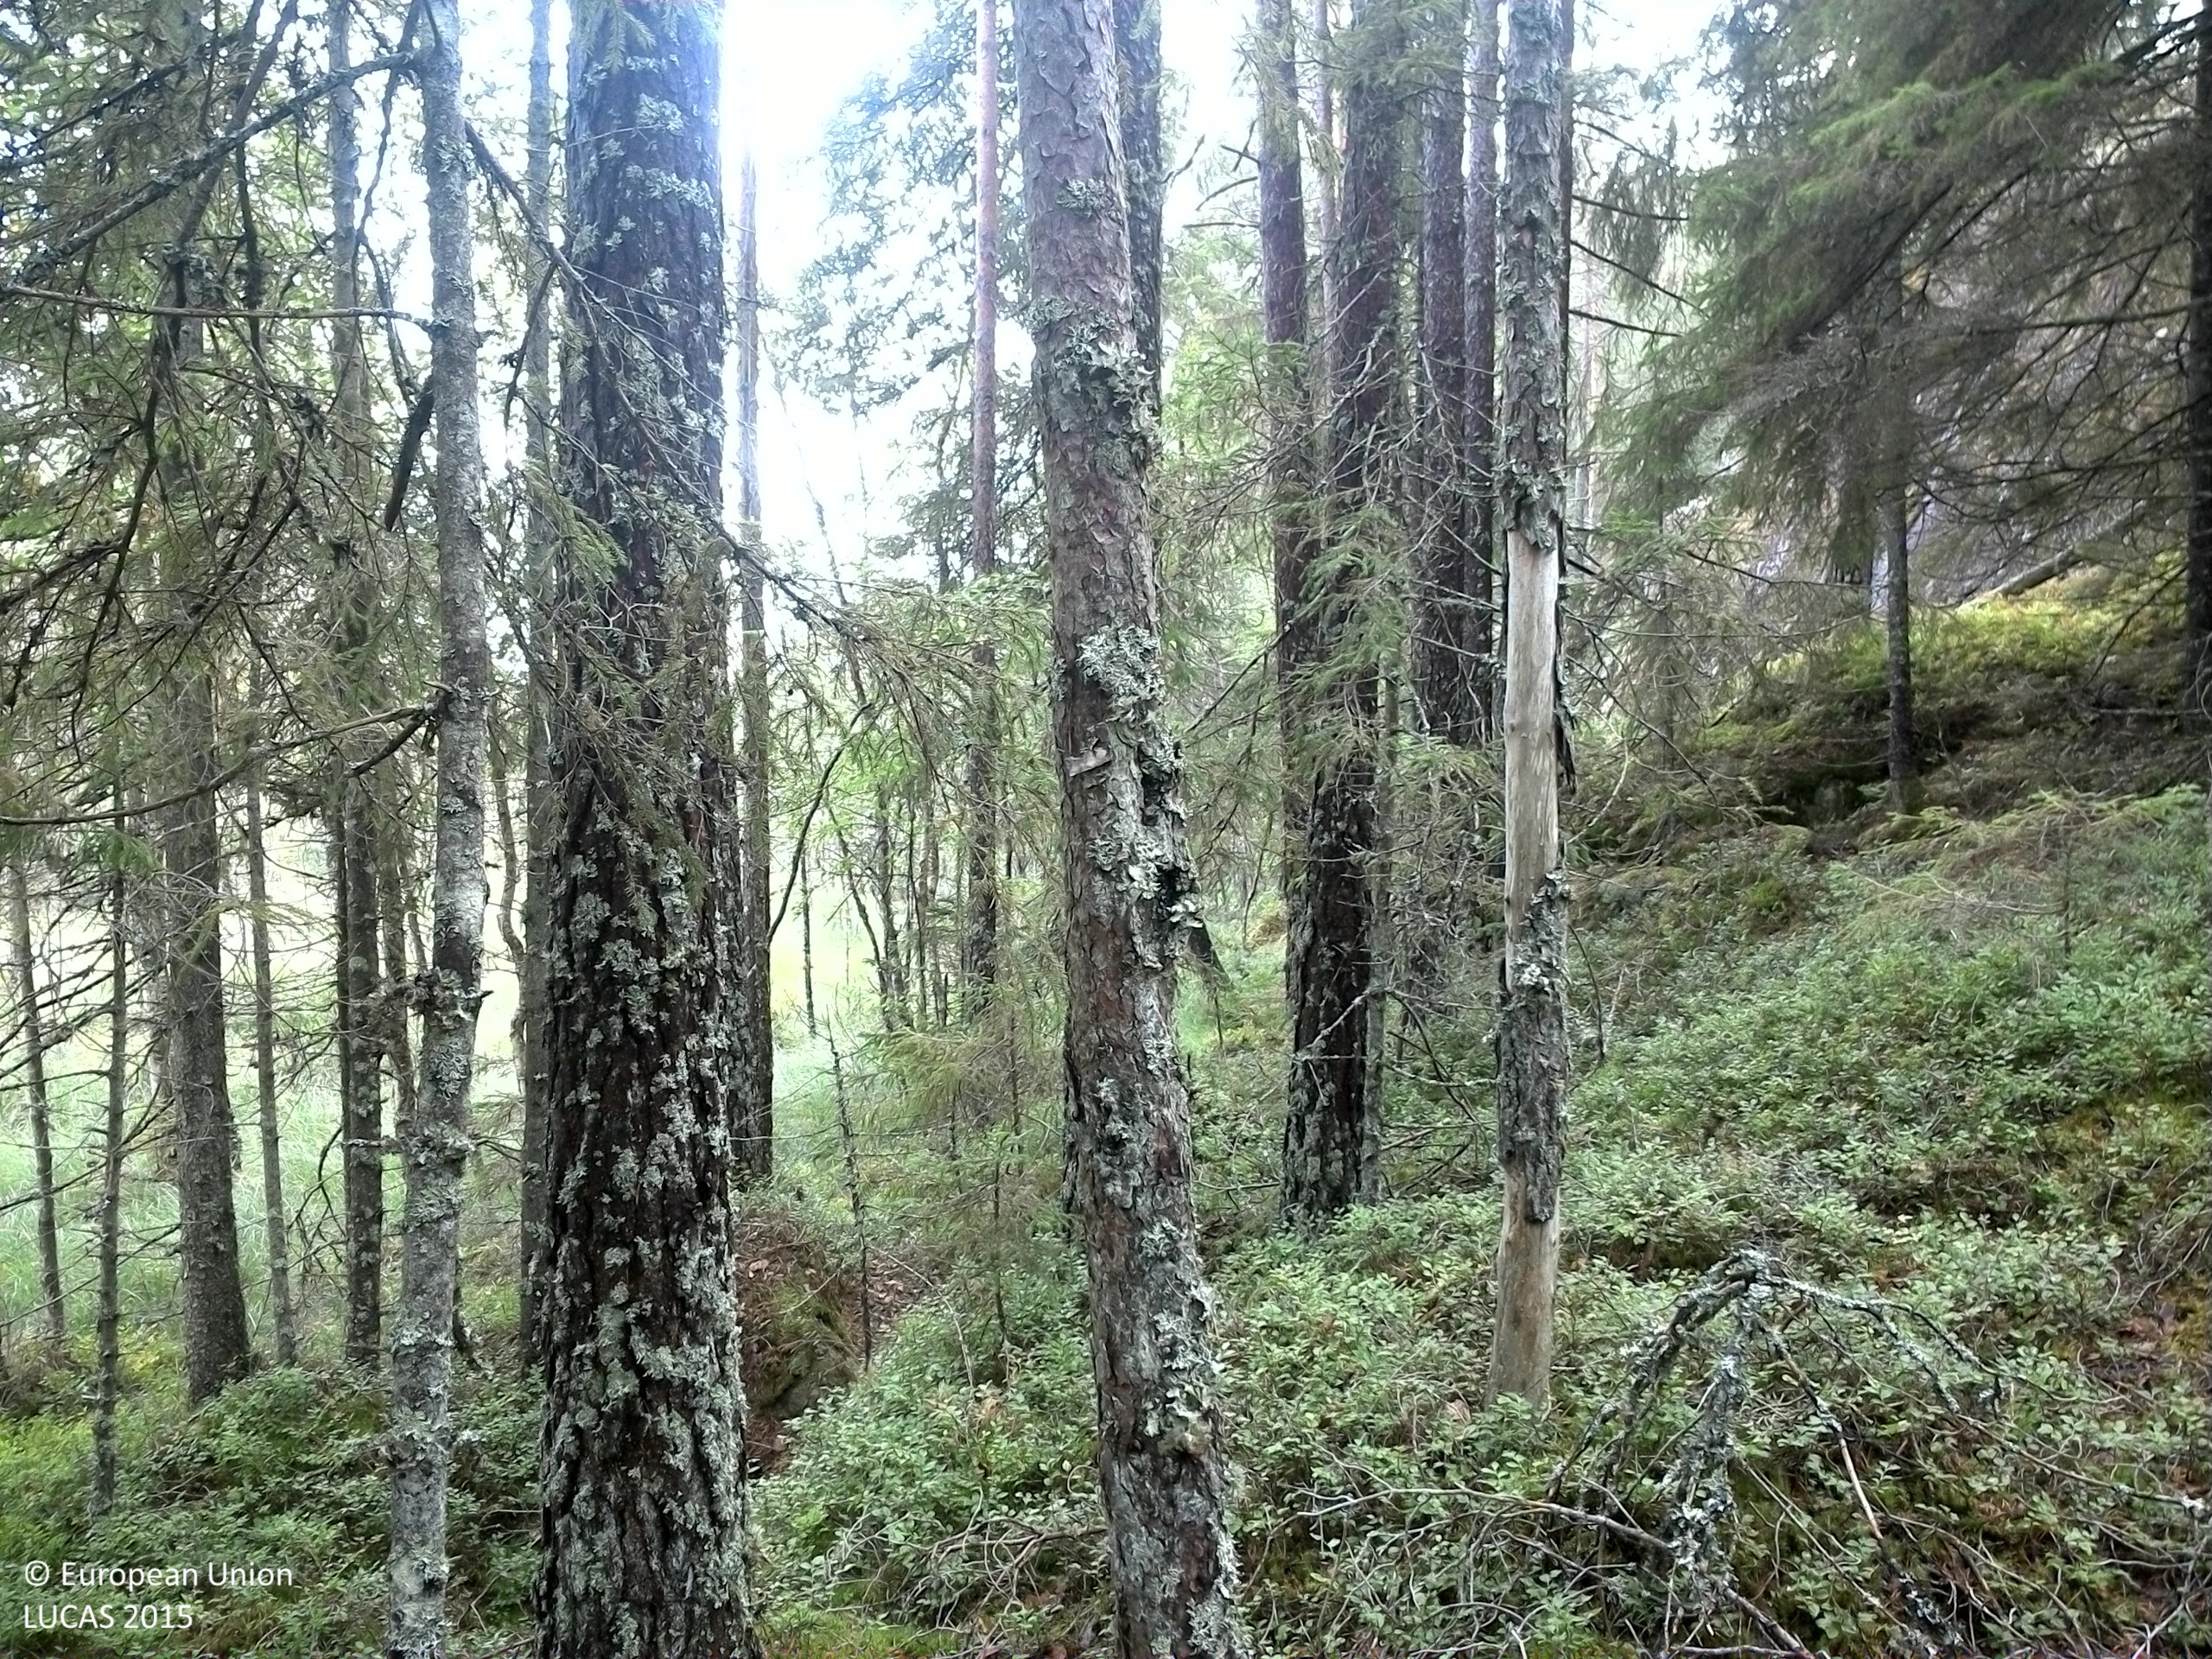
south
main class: Woodland
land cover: Pine dominated coniferous woodland
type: boreal forest
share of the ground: 50 - 75 %
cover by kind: coniferous forest trees 65 %, shrubs 20 %, lichens and mosses 10 %, broadleaved forest trees 5 %
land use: Forestry
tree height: > 5 m
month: September
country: SE
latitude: 59.3021
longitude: 12.0145
